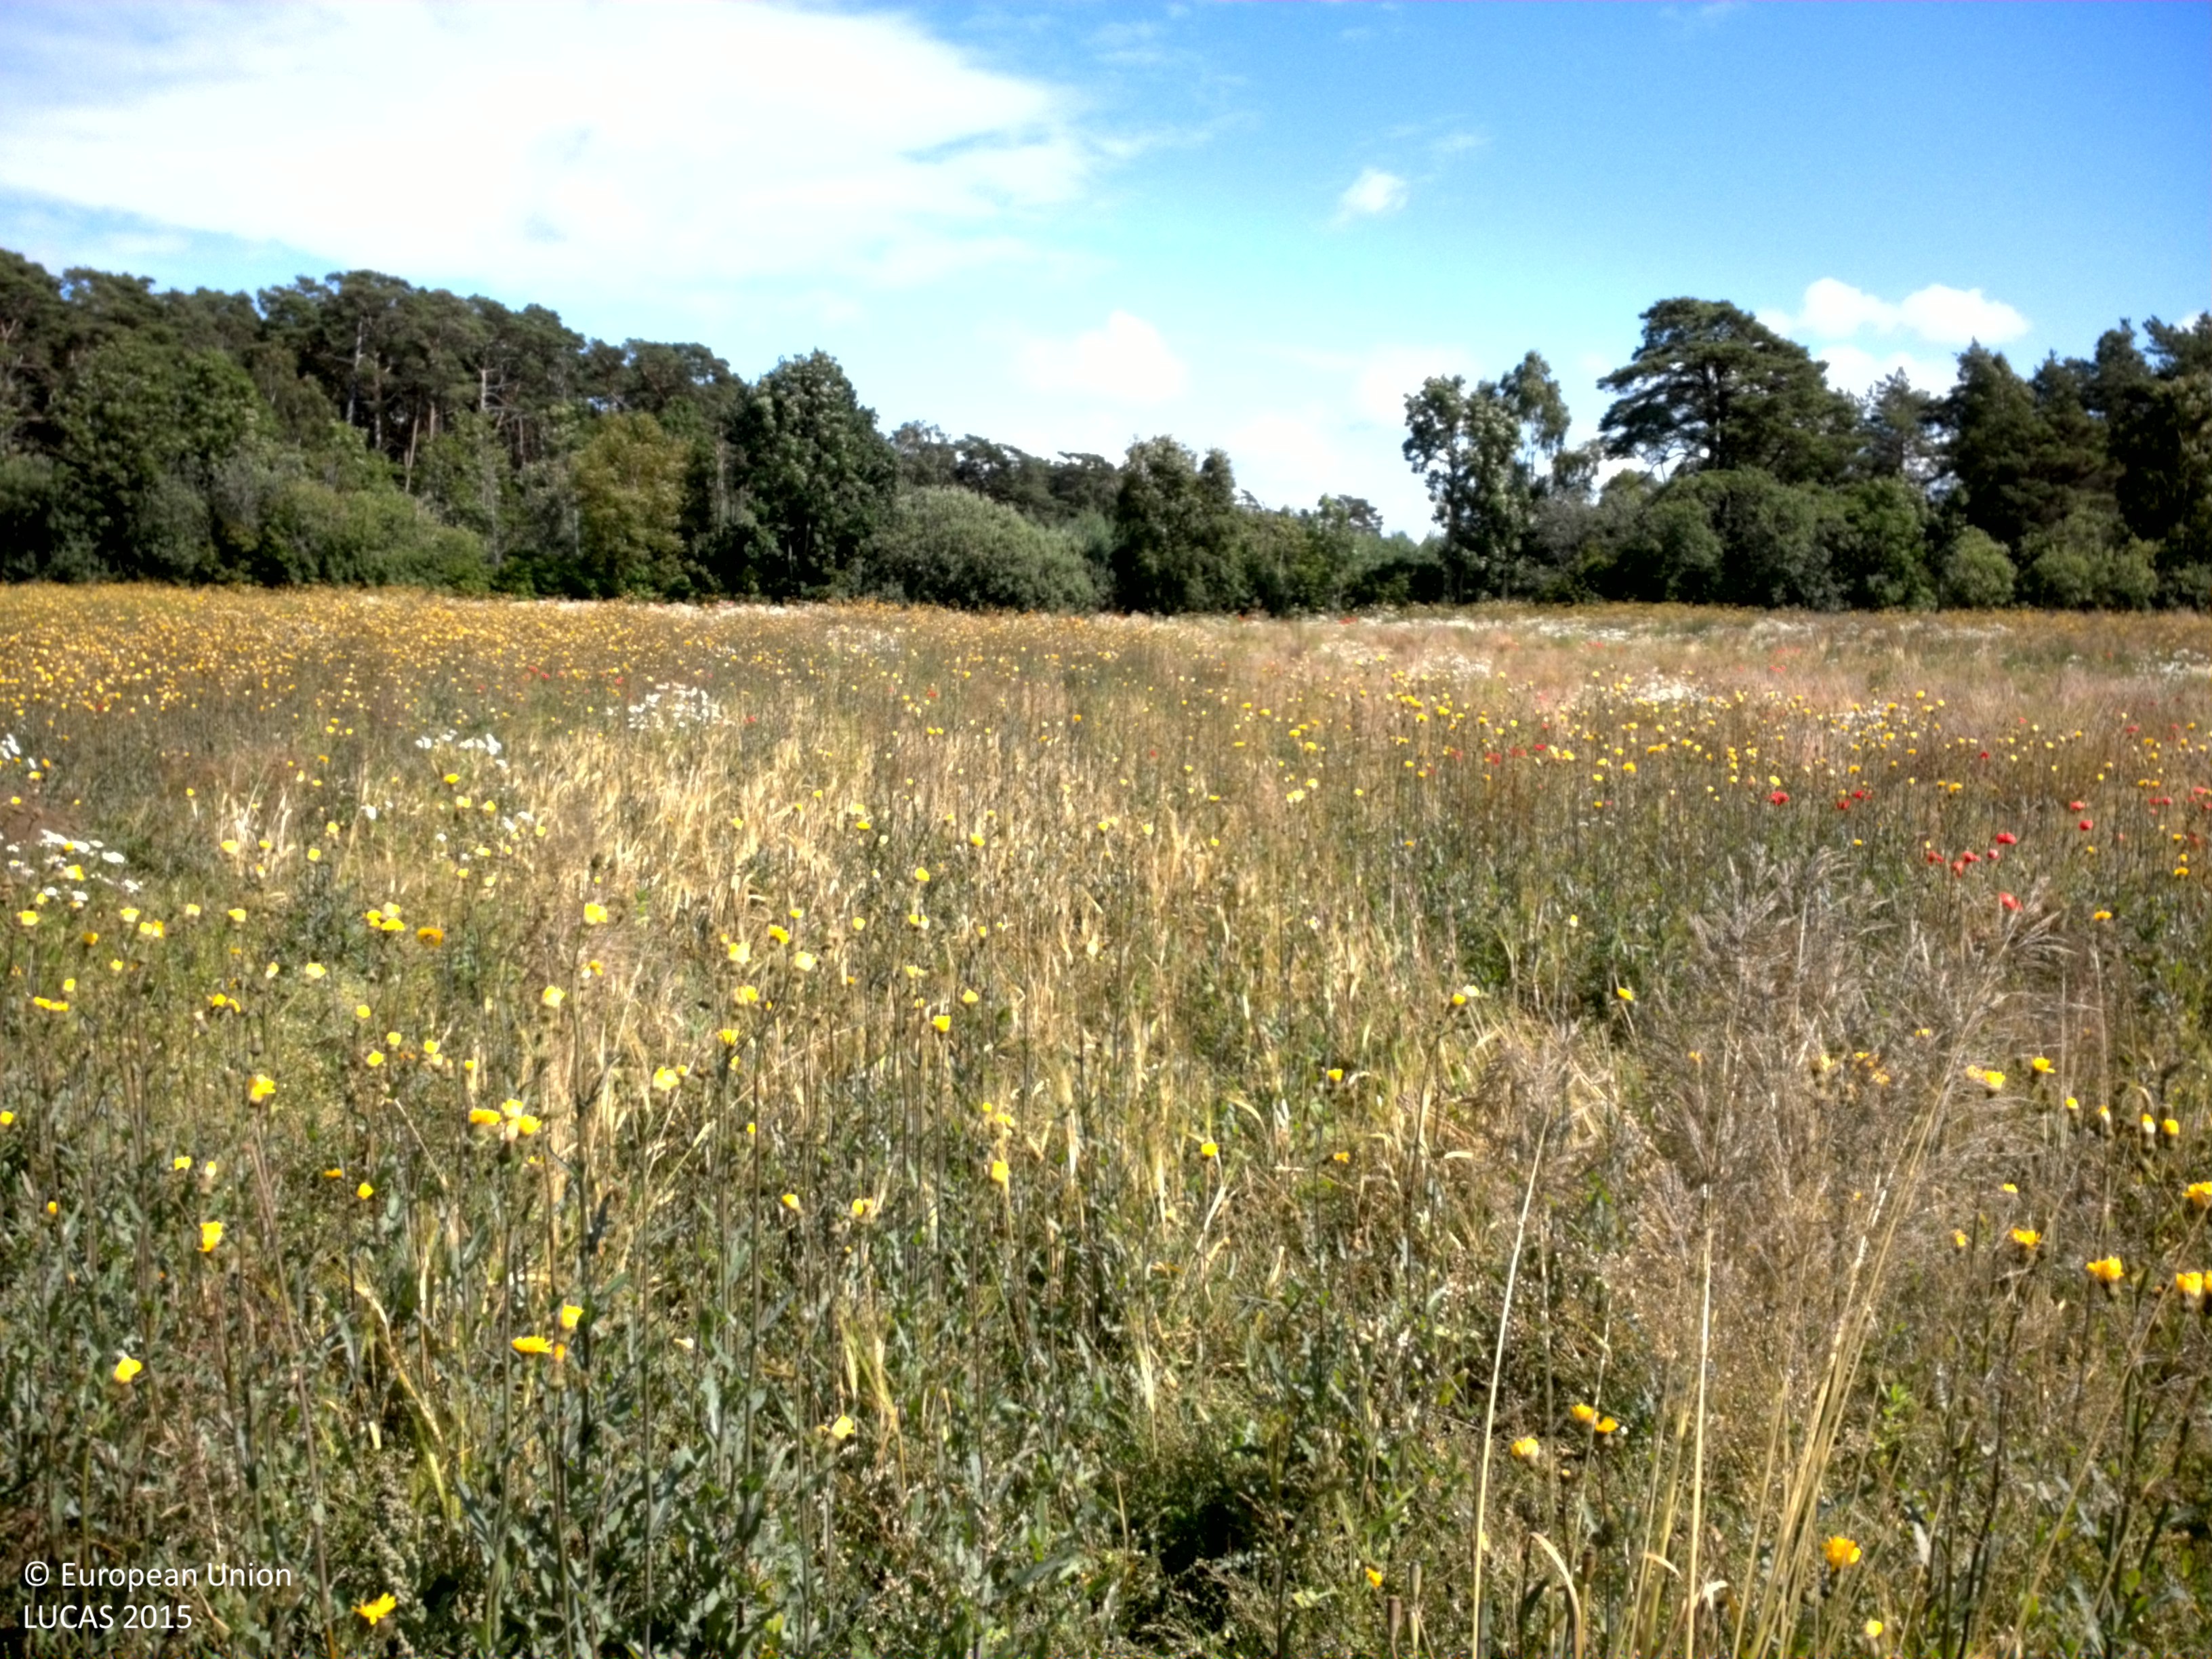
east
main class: Cropland
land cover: Temporary grasslands
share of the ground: > 75 %
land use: Agriculture (excluding fallow land and kitchen gardens)
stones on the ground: < 10 %
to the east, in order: Temporary grasslands; Abandoned hedges; Ditches and canals; Fences; Spontaneously vegetated surfaces; Fences; Pine dominated coniferous woodland
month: July
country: SE
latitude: 57.2823
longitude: 18.1856
